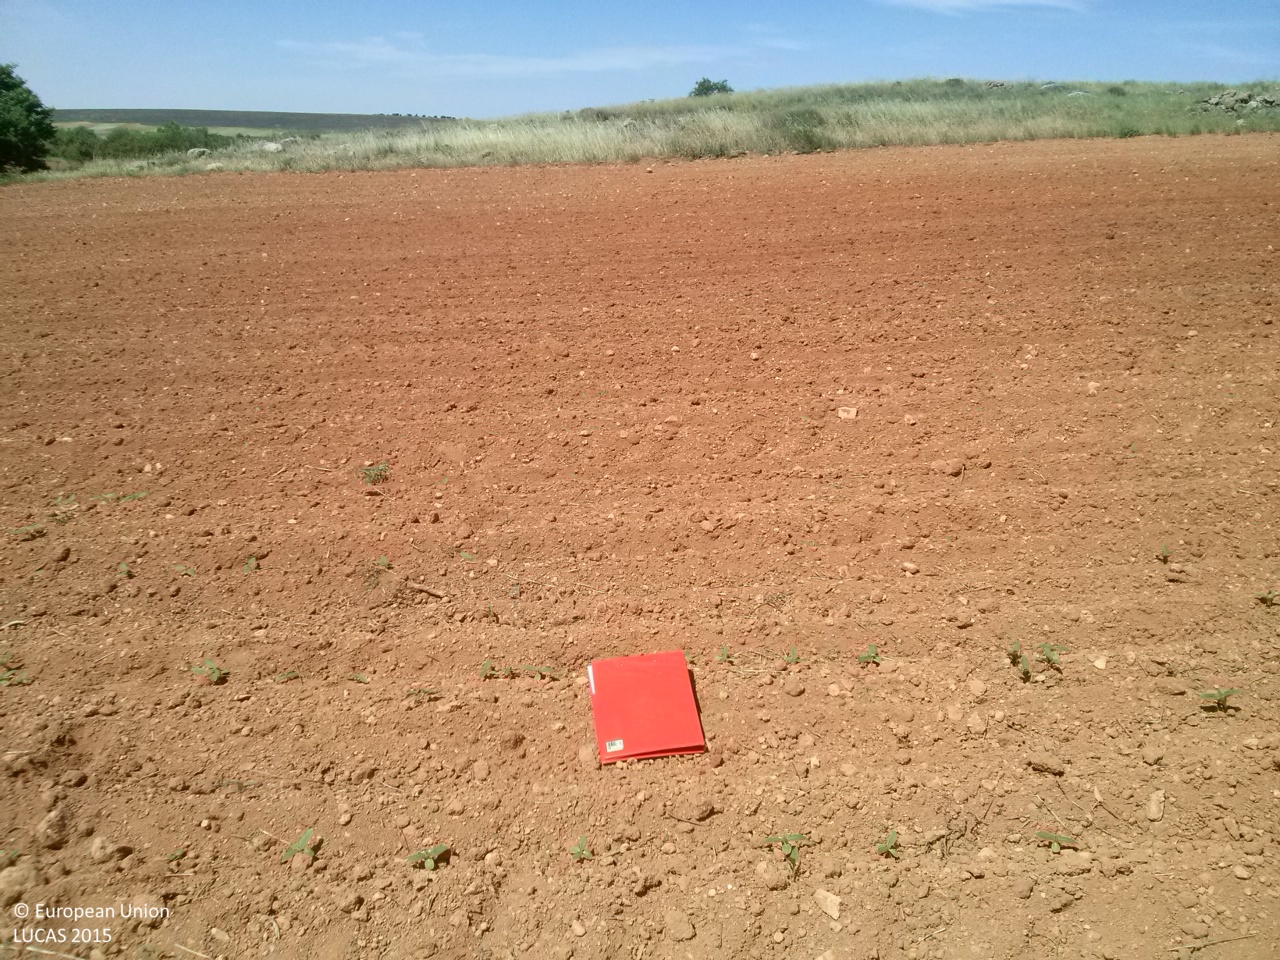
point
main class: Cropland
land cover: Sunflower
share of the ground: < 10 %
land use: Agriculture (excluding fallow land and kitchen gardens)
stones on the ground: < 10 %
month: May
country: ES
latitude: 40.0010
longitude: -2.8719
